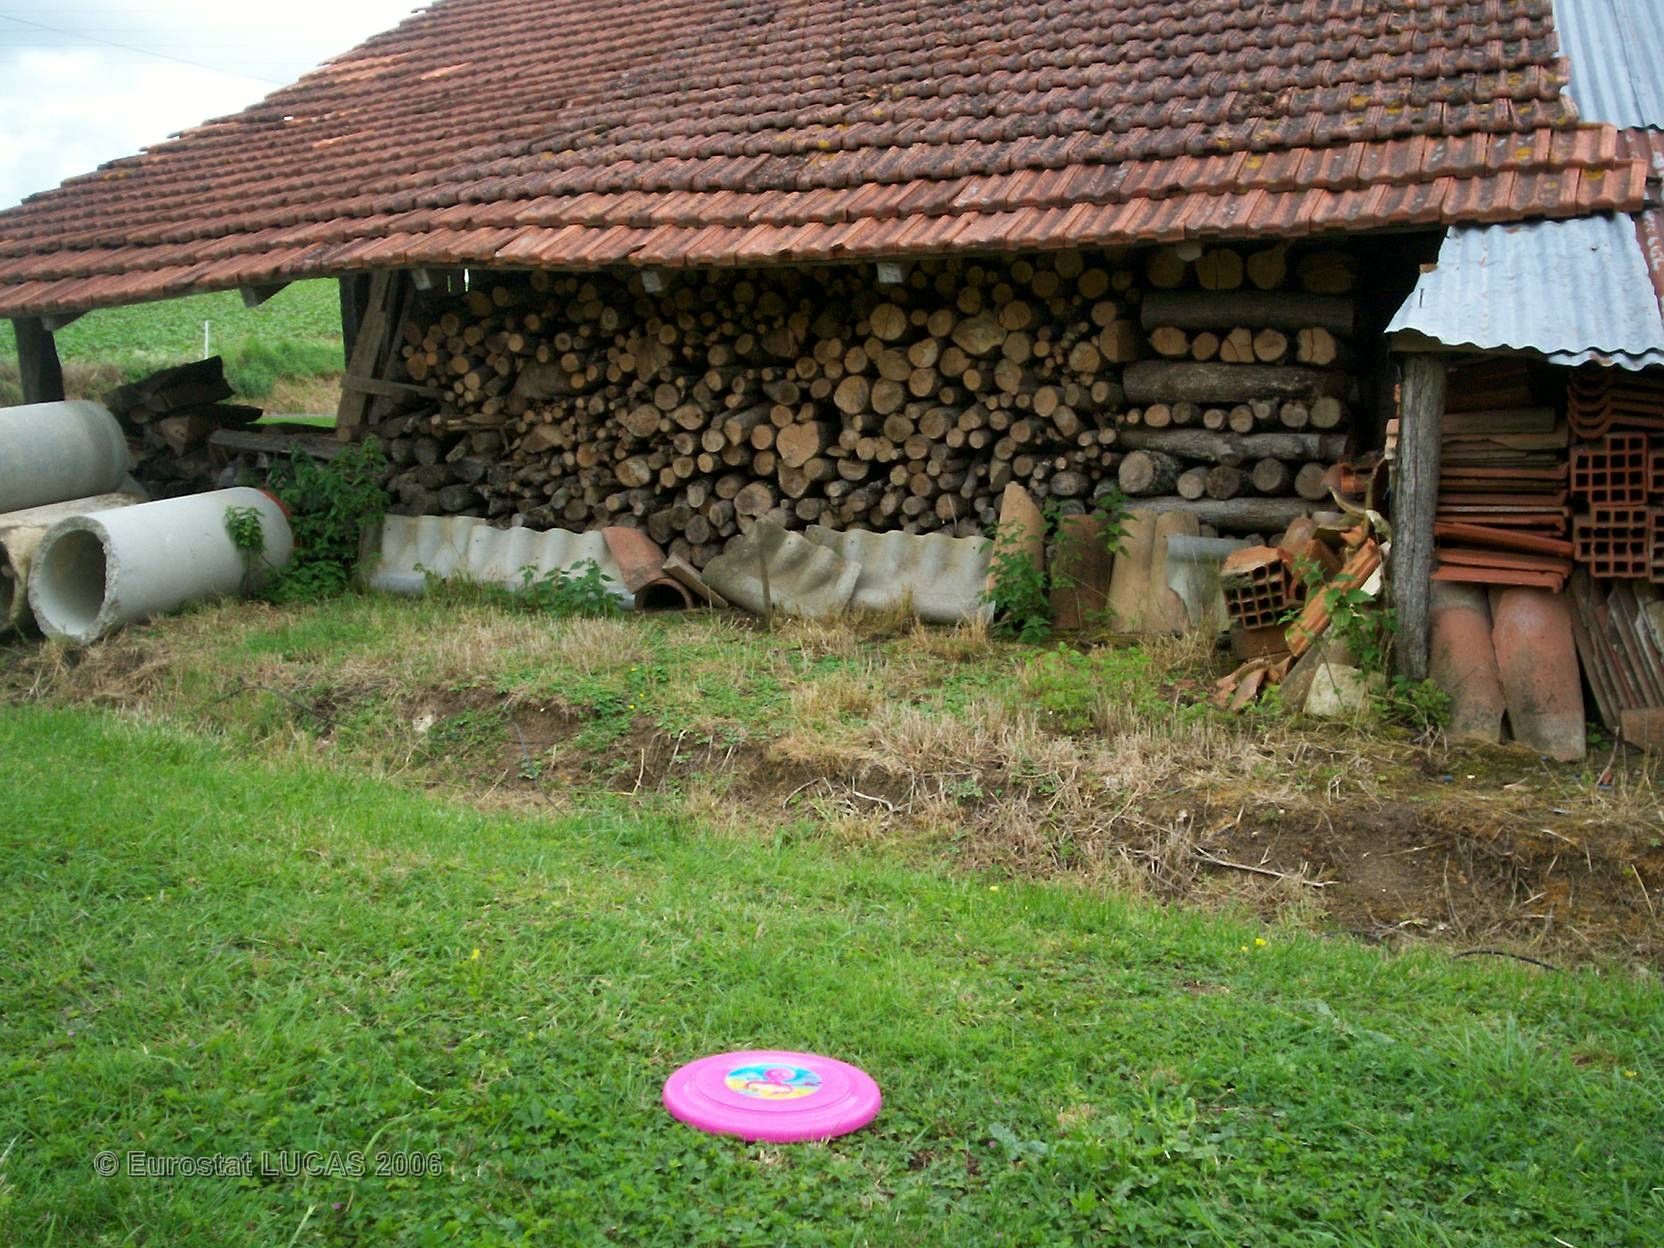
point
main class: Grassland
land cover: Grassland without tree/shrub cover
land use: Residential
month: May
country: FR
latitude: 43.6292
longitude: 0.9648
